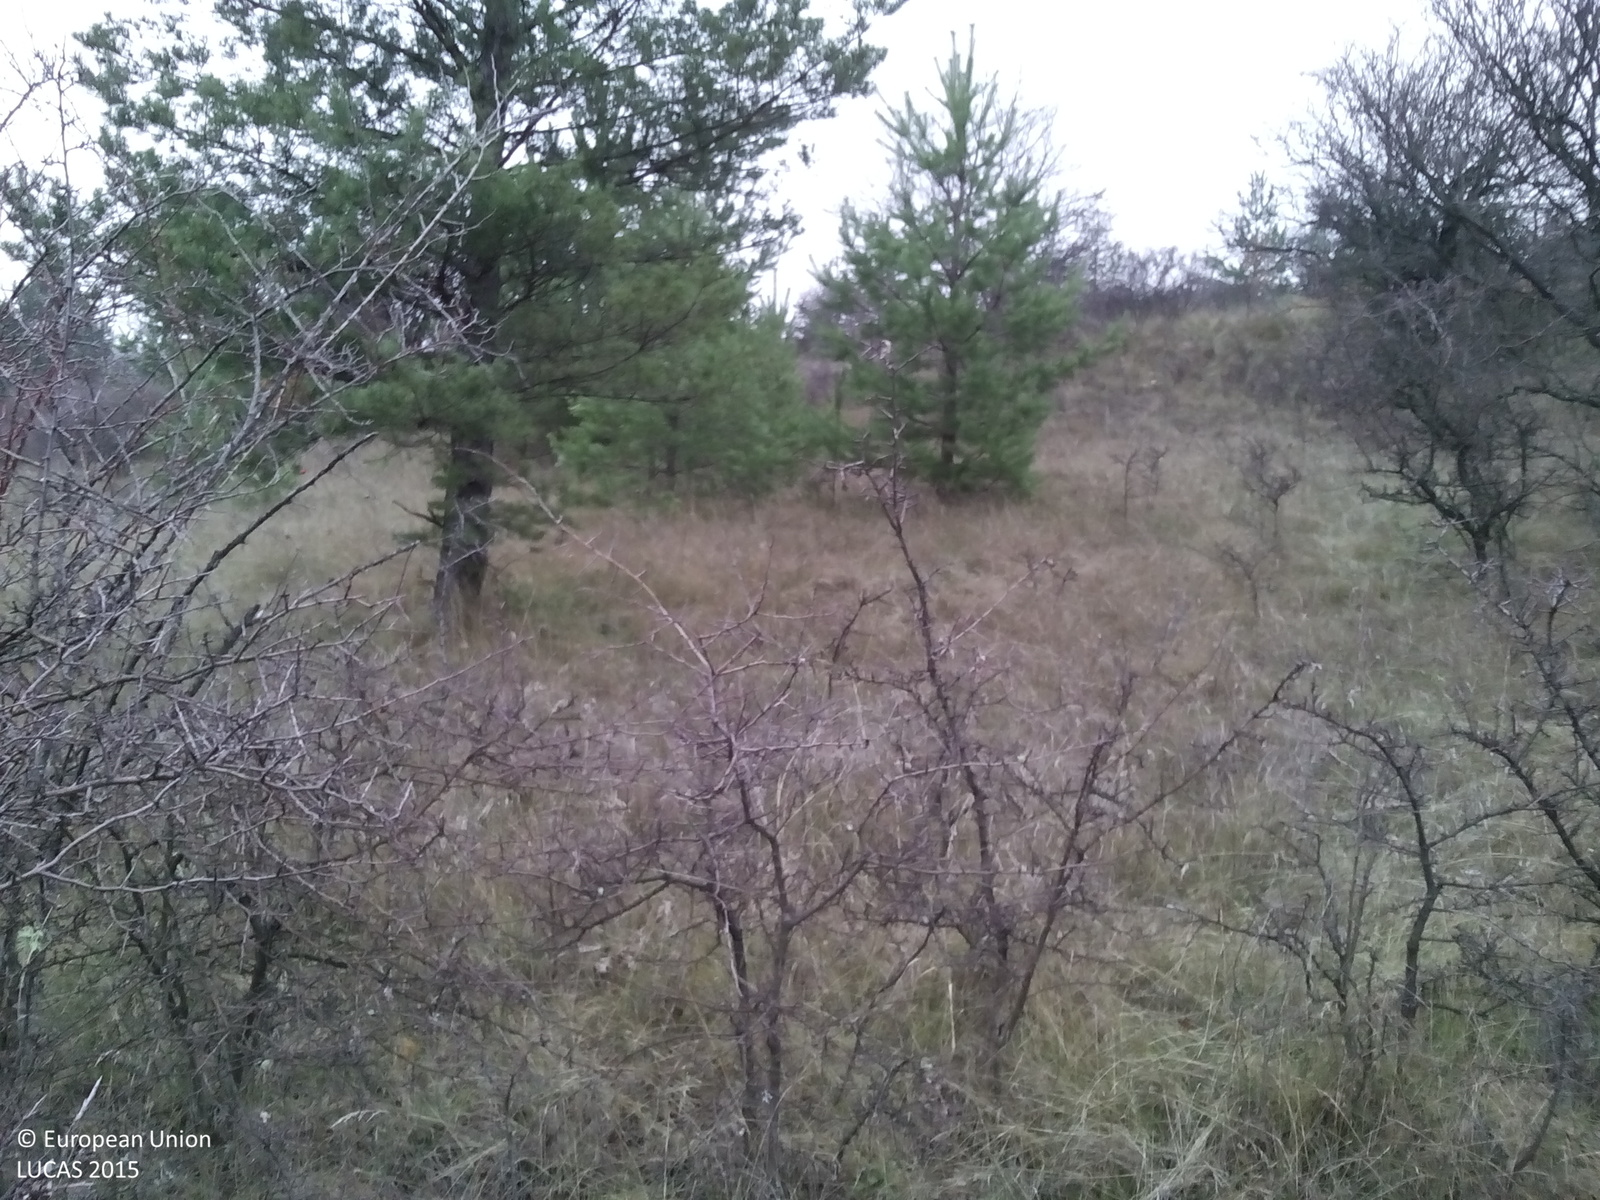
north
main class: Shrubland
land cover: Shrubland with sparse tree cover
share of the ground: 25 - 50 %
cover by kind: herbaceous plants 55 %, shrubs 40 %, coniferous forest trees 5 %
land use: Semi-natural and natural areas not in use
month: December
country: BG
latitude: 42.7959
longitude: 22.8789
